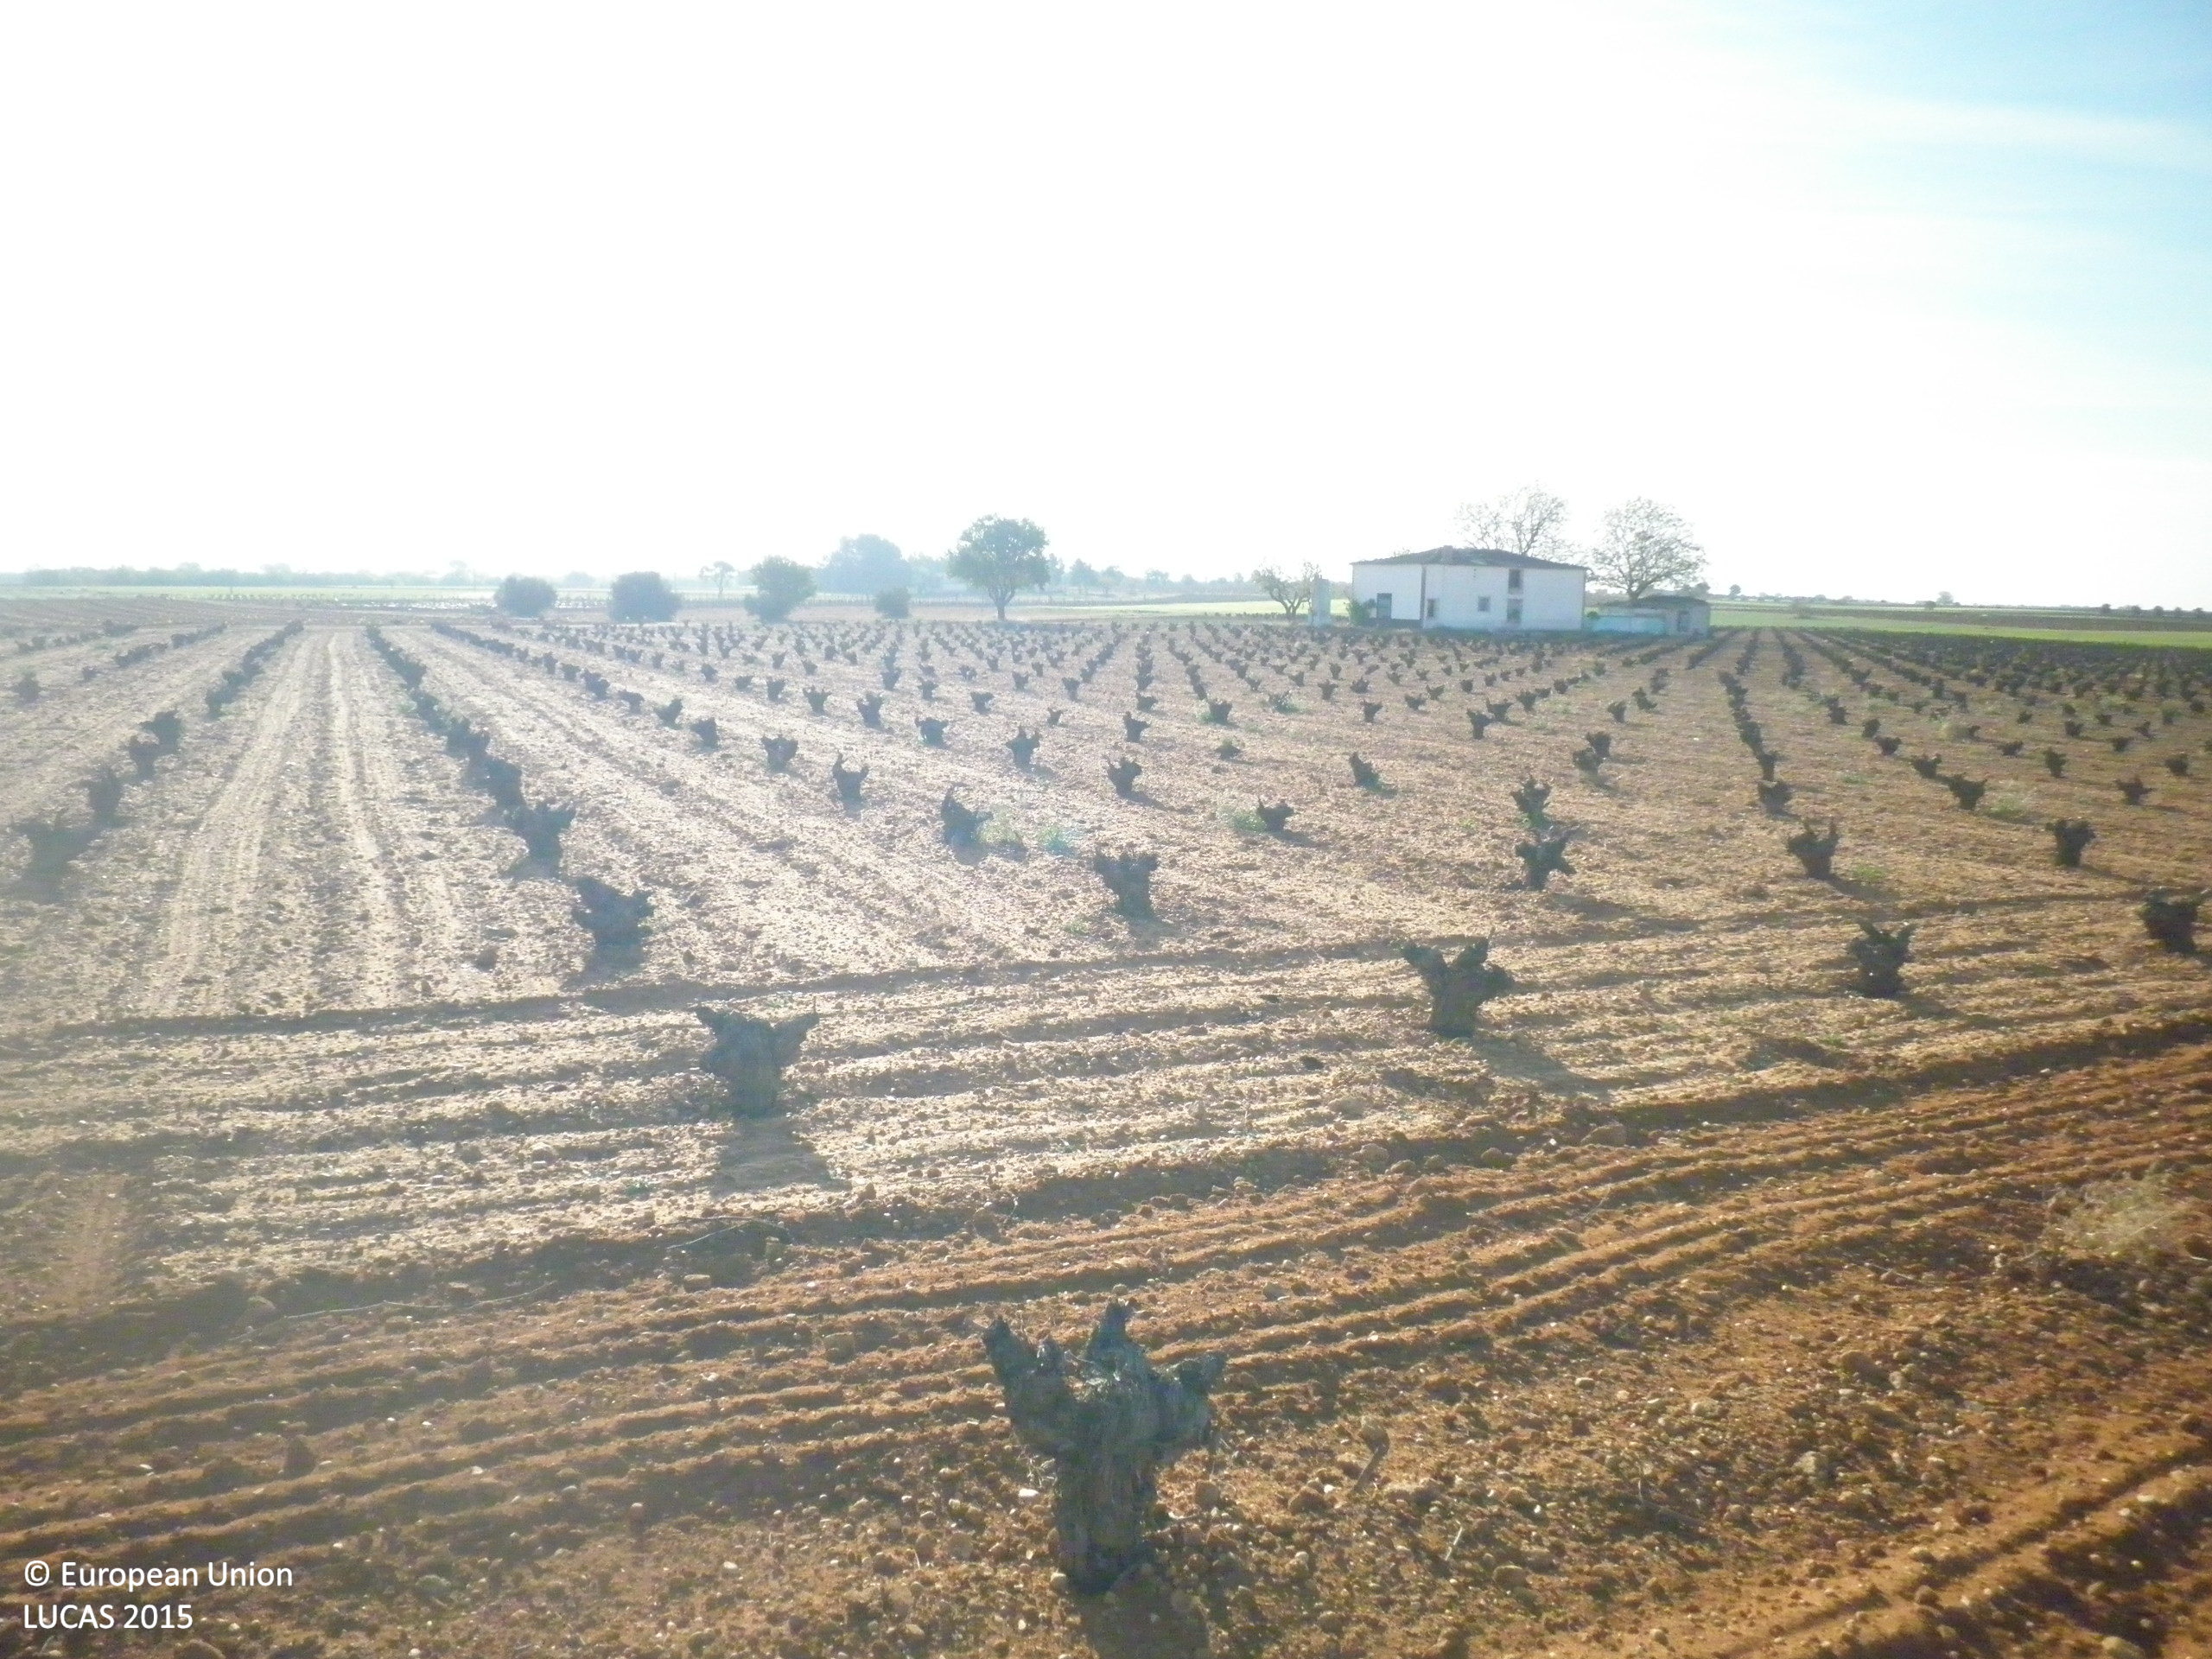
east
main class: Cropland
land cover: Vineyards
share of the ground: < 10 %
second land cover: Other bare soil
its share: > 75 %
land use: Agriculture (excluding fallow land and kitchen gardens)
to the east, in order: Vineyards; Other bare soil; Tracks; Other bare soil; Single bushes/trees; Other bare soil; Vineyards
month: April
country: ES
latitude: 39.3655
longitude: -2.5577
